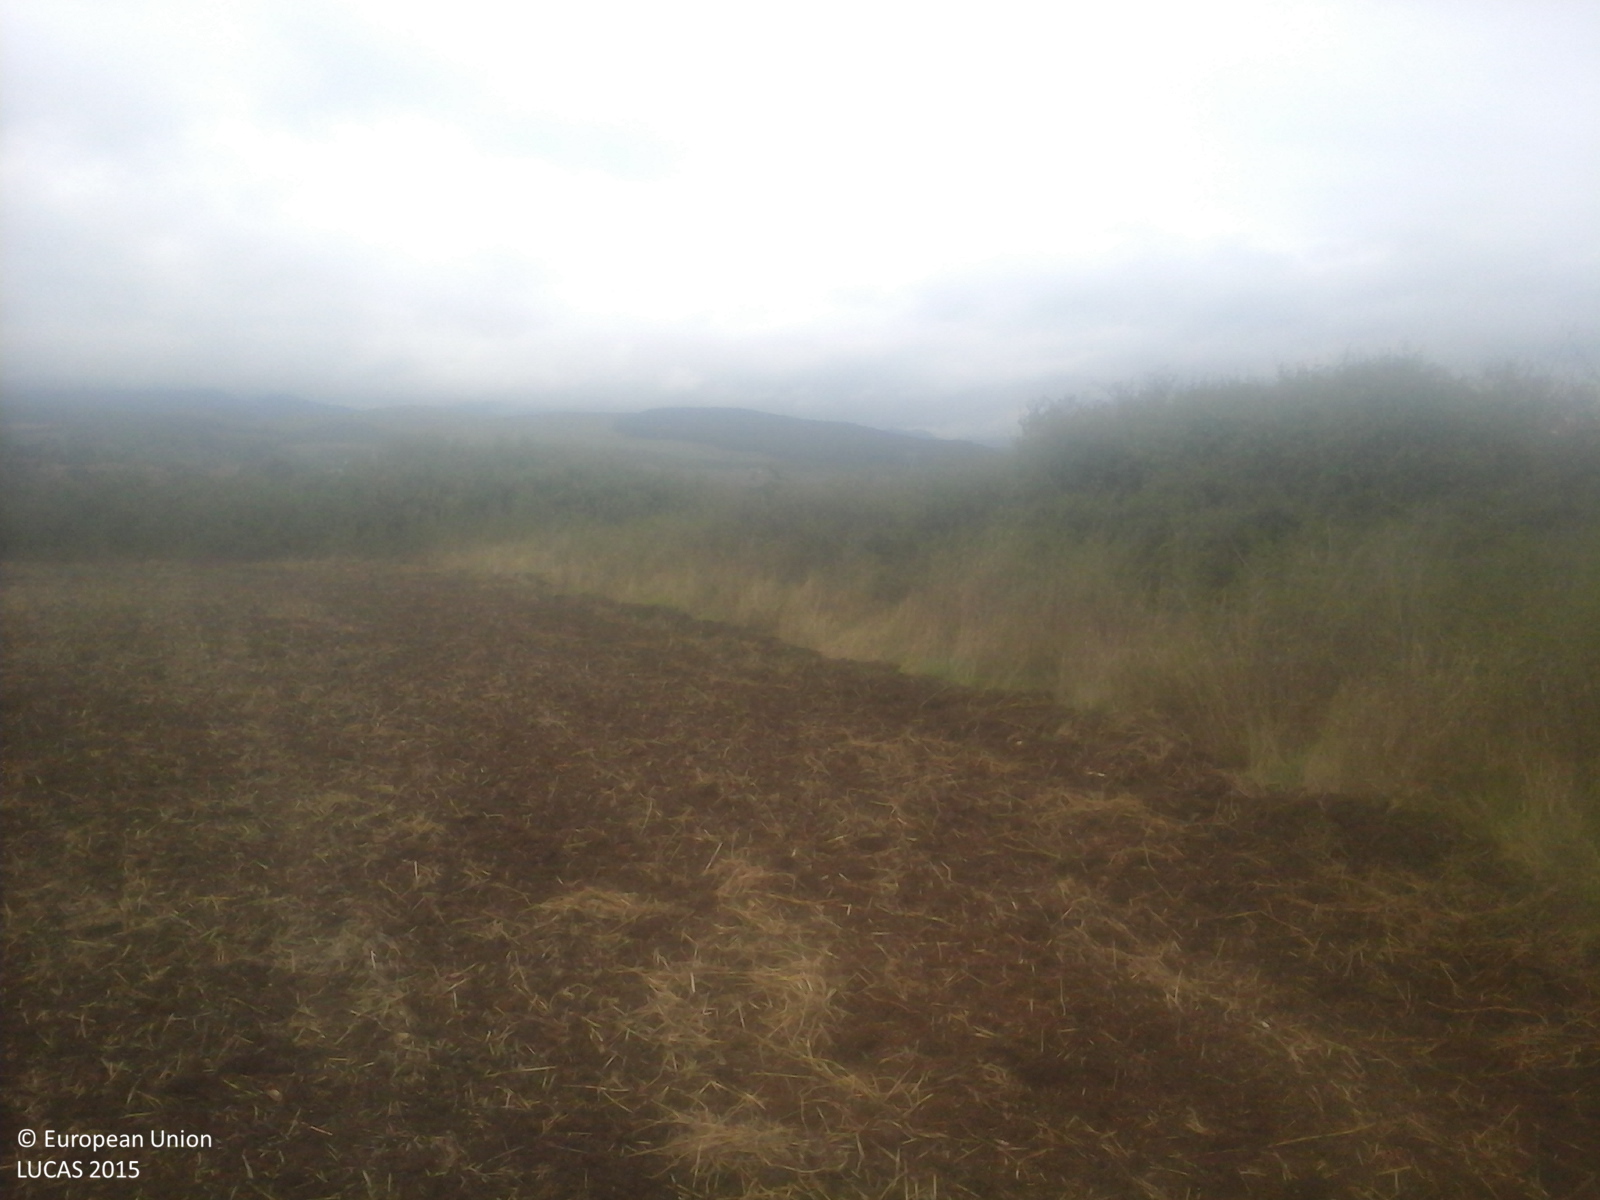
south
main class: Cropland
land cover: Common wheat
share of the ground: < 10 %
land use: Agriculture (excluding fallow land and kitchen gardens)
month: September
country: RO
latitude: 45.9399
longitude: 23.4125
